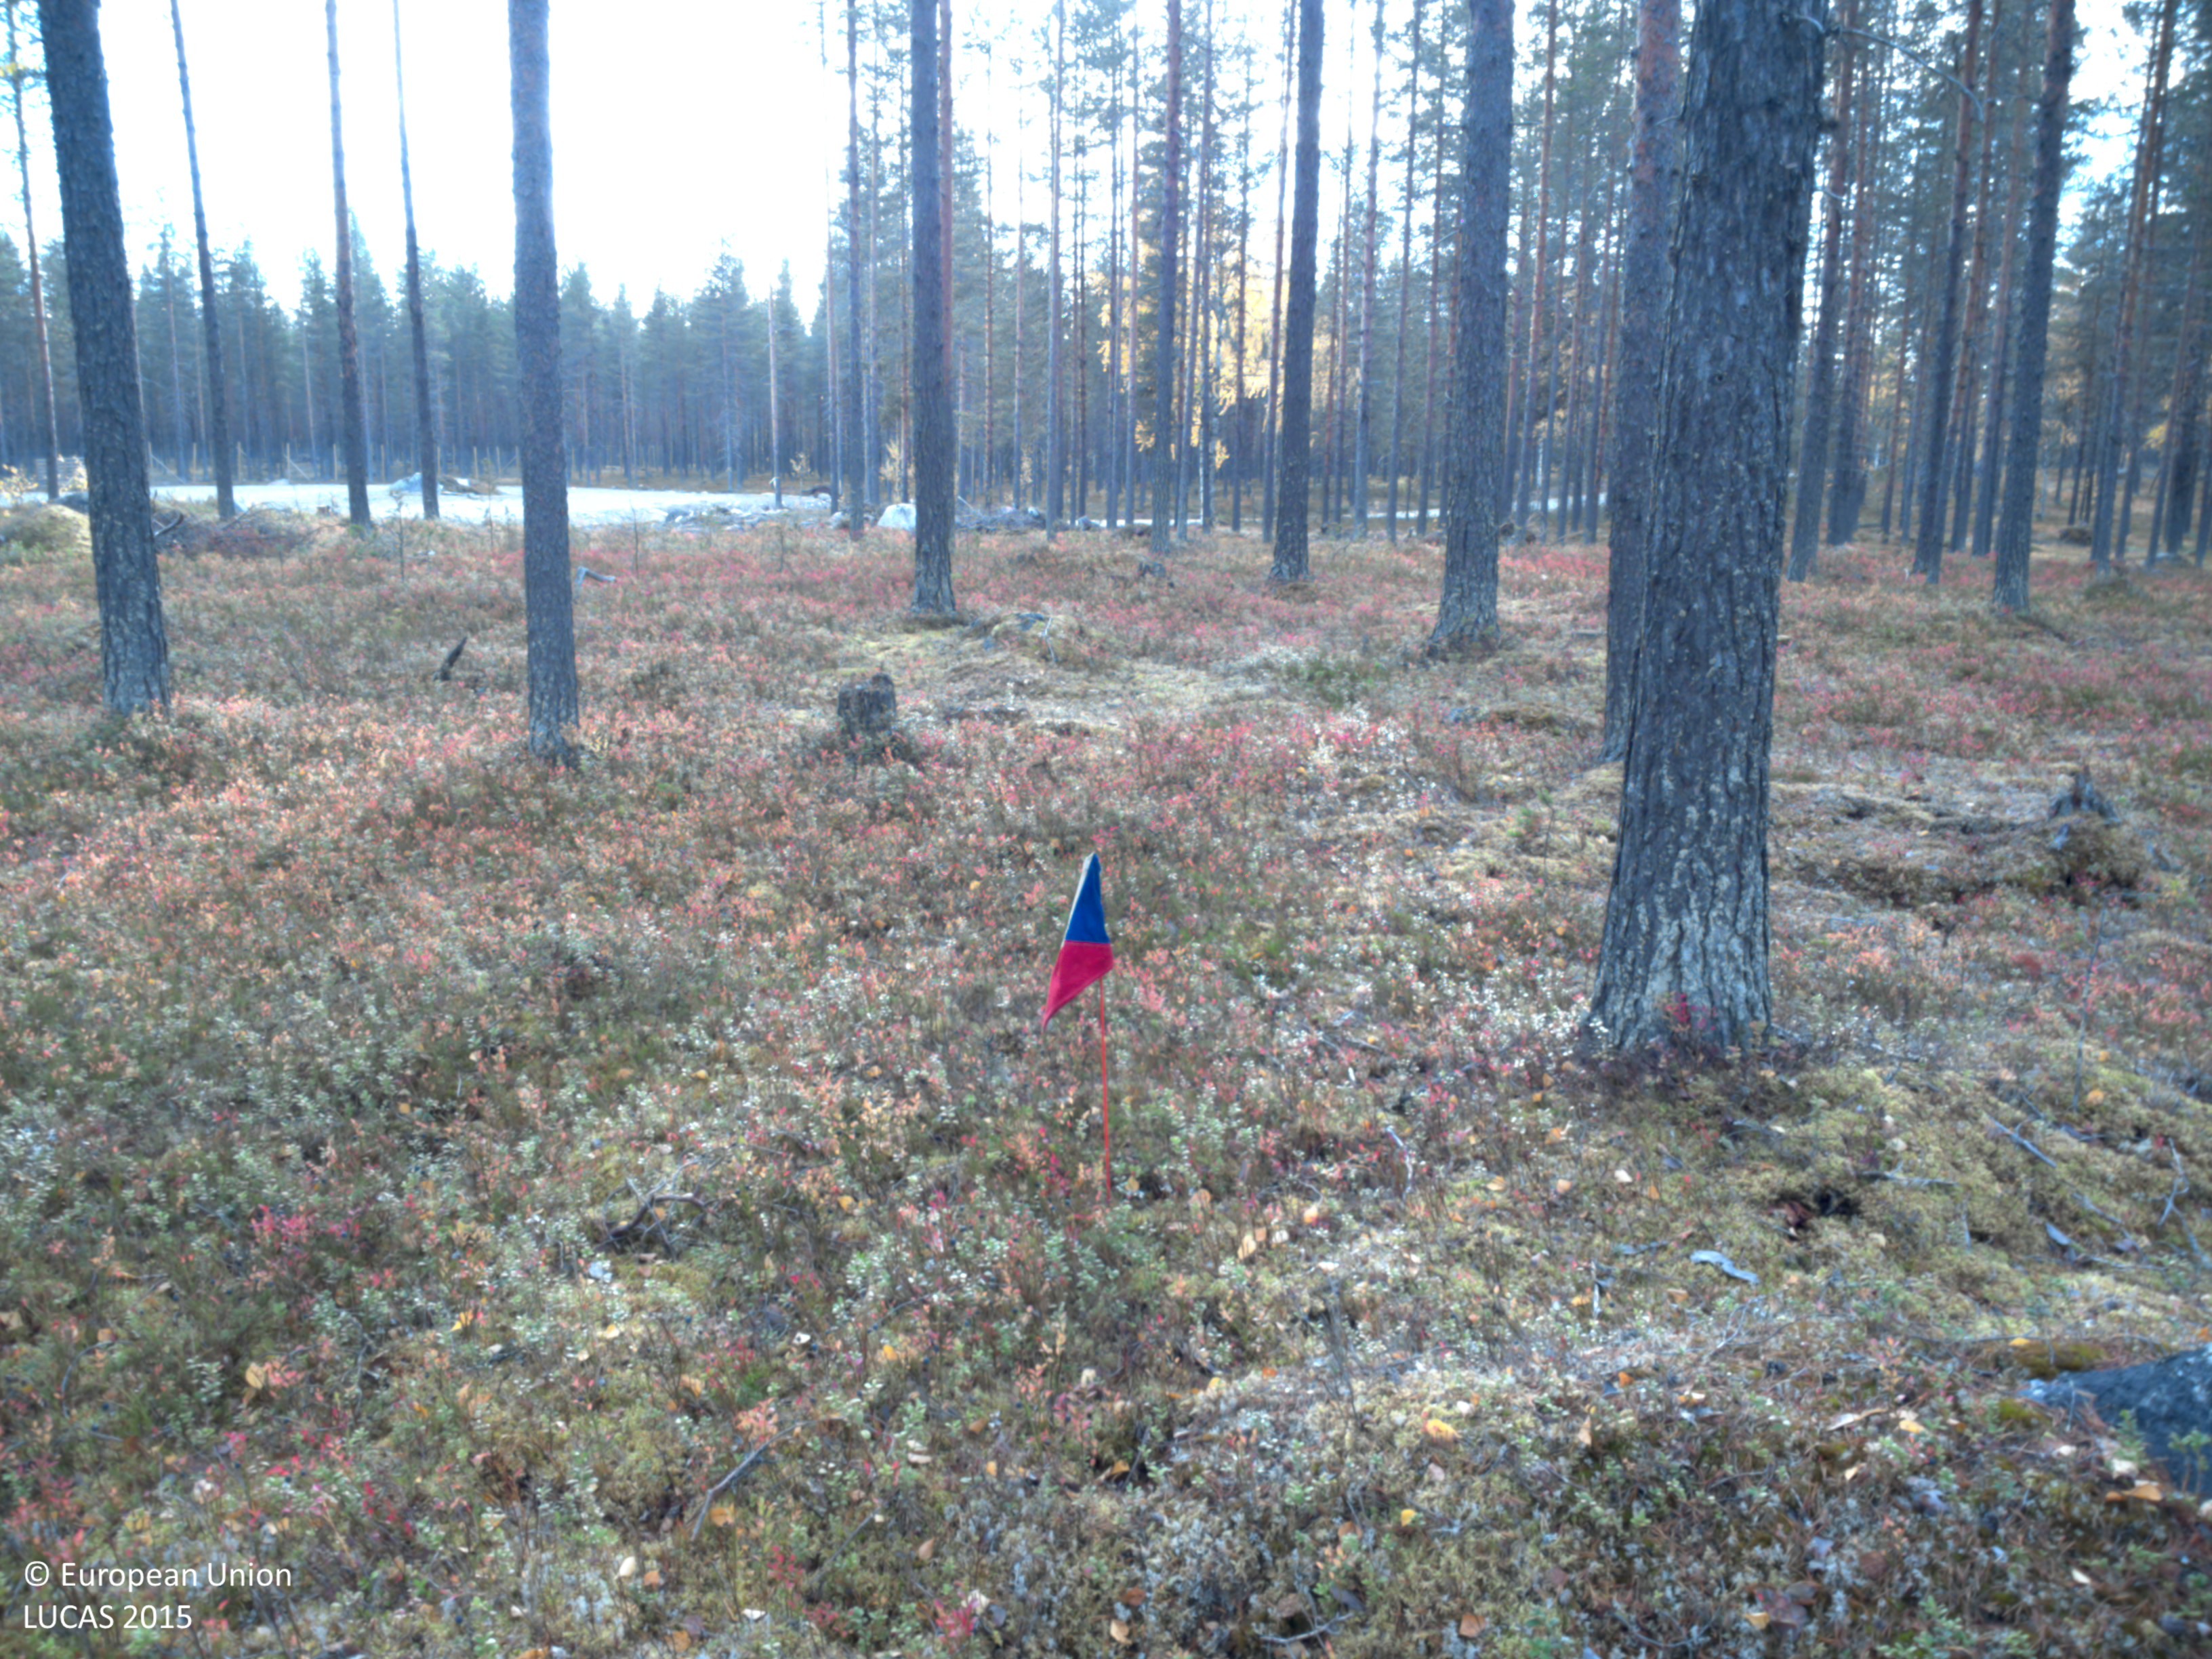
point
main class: Woodland
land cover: Pine dominated coniferous woodland
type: boreal forest
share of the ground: > 75 %
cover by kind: coniferous forest trees 55 %, shrubs 30 %, lichens and mosses 5 %, consolidated bare surface 5 %
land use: Forestry
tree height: > 5 m
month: September
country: SE
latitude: 64.8964
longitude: 18.5207
